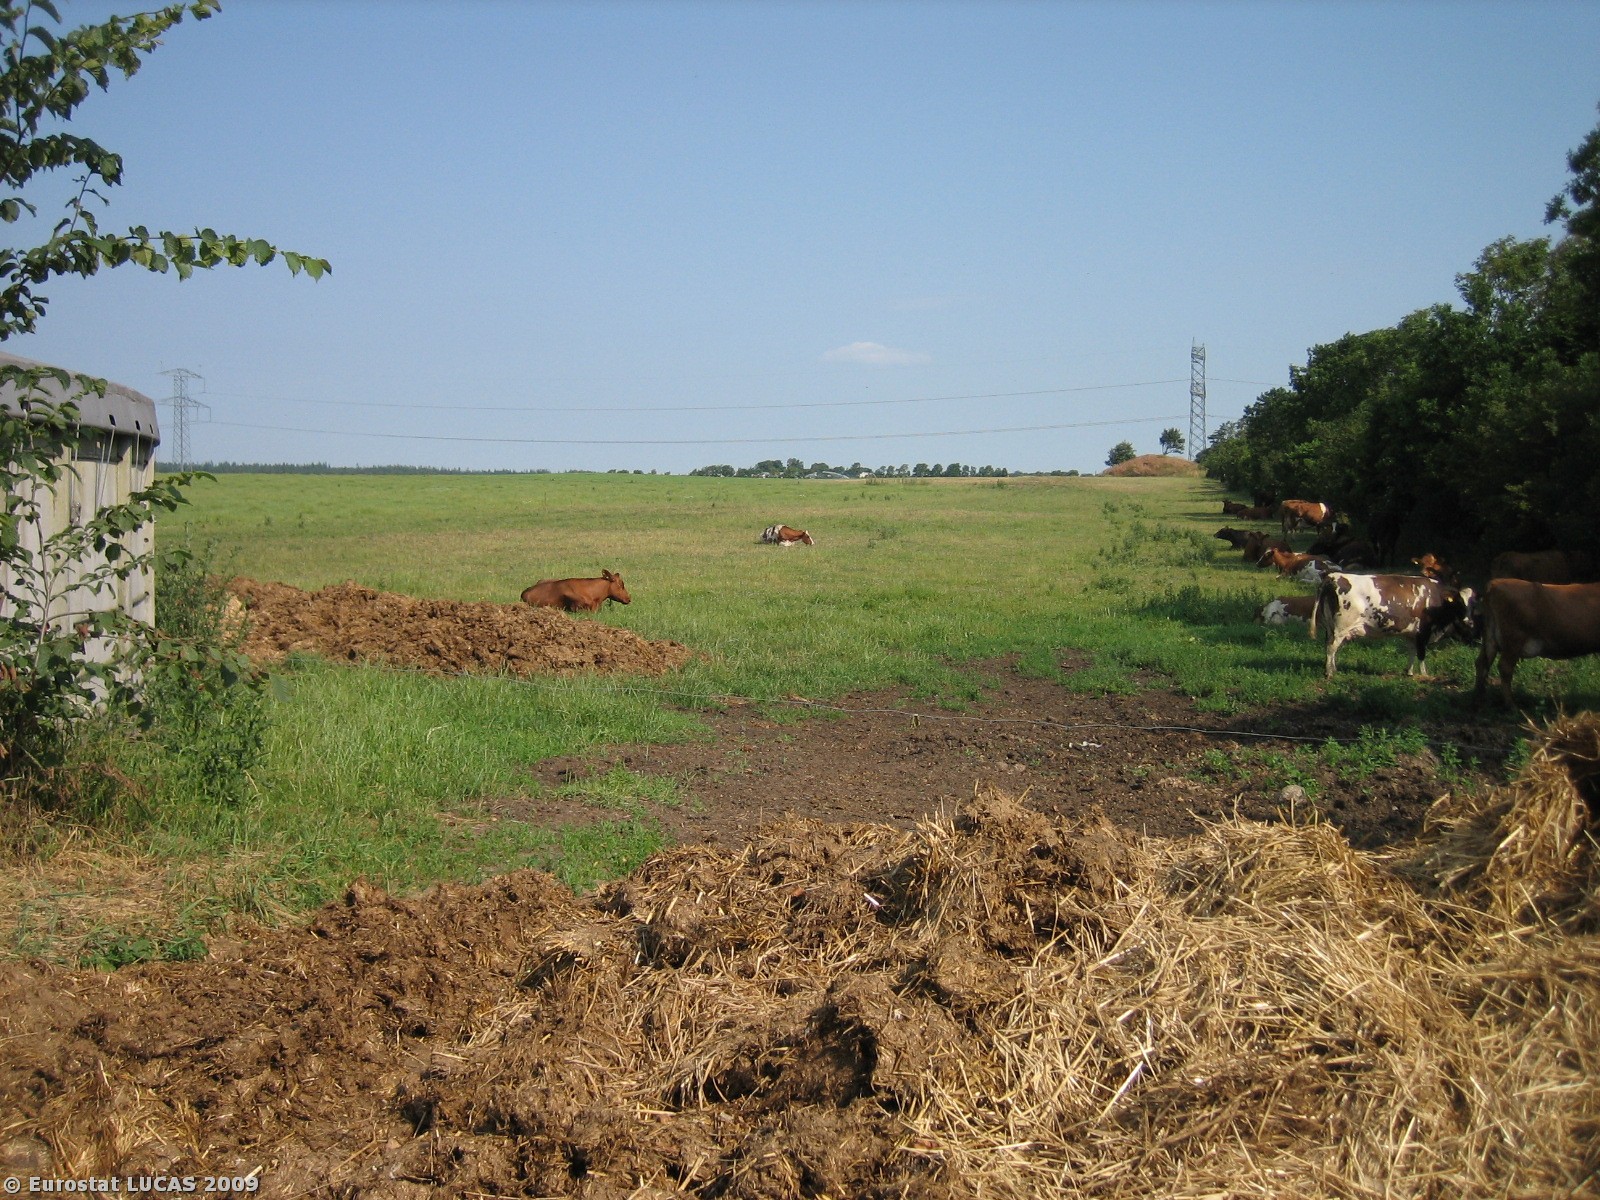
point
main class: Grassland
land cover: Grassland without tree/shrub cover
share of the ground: > 75 %
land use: Agriculture (excluding fallow land and kitchen gardens)
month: July
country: DK
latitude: 55.5187
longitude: 9.0031
